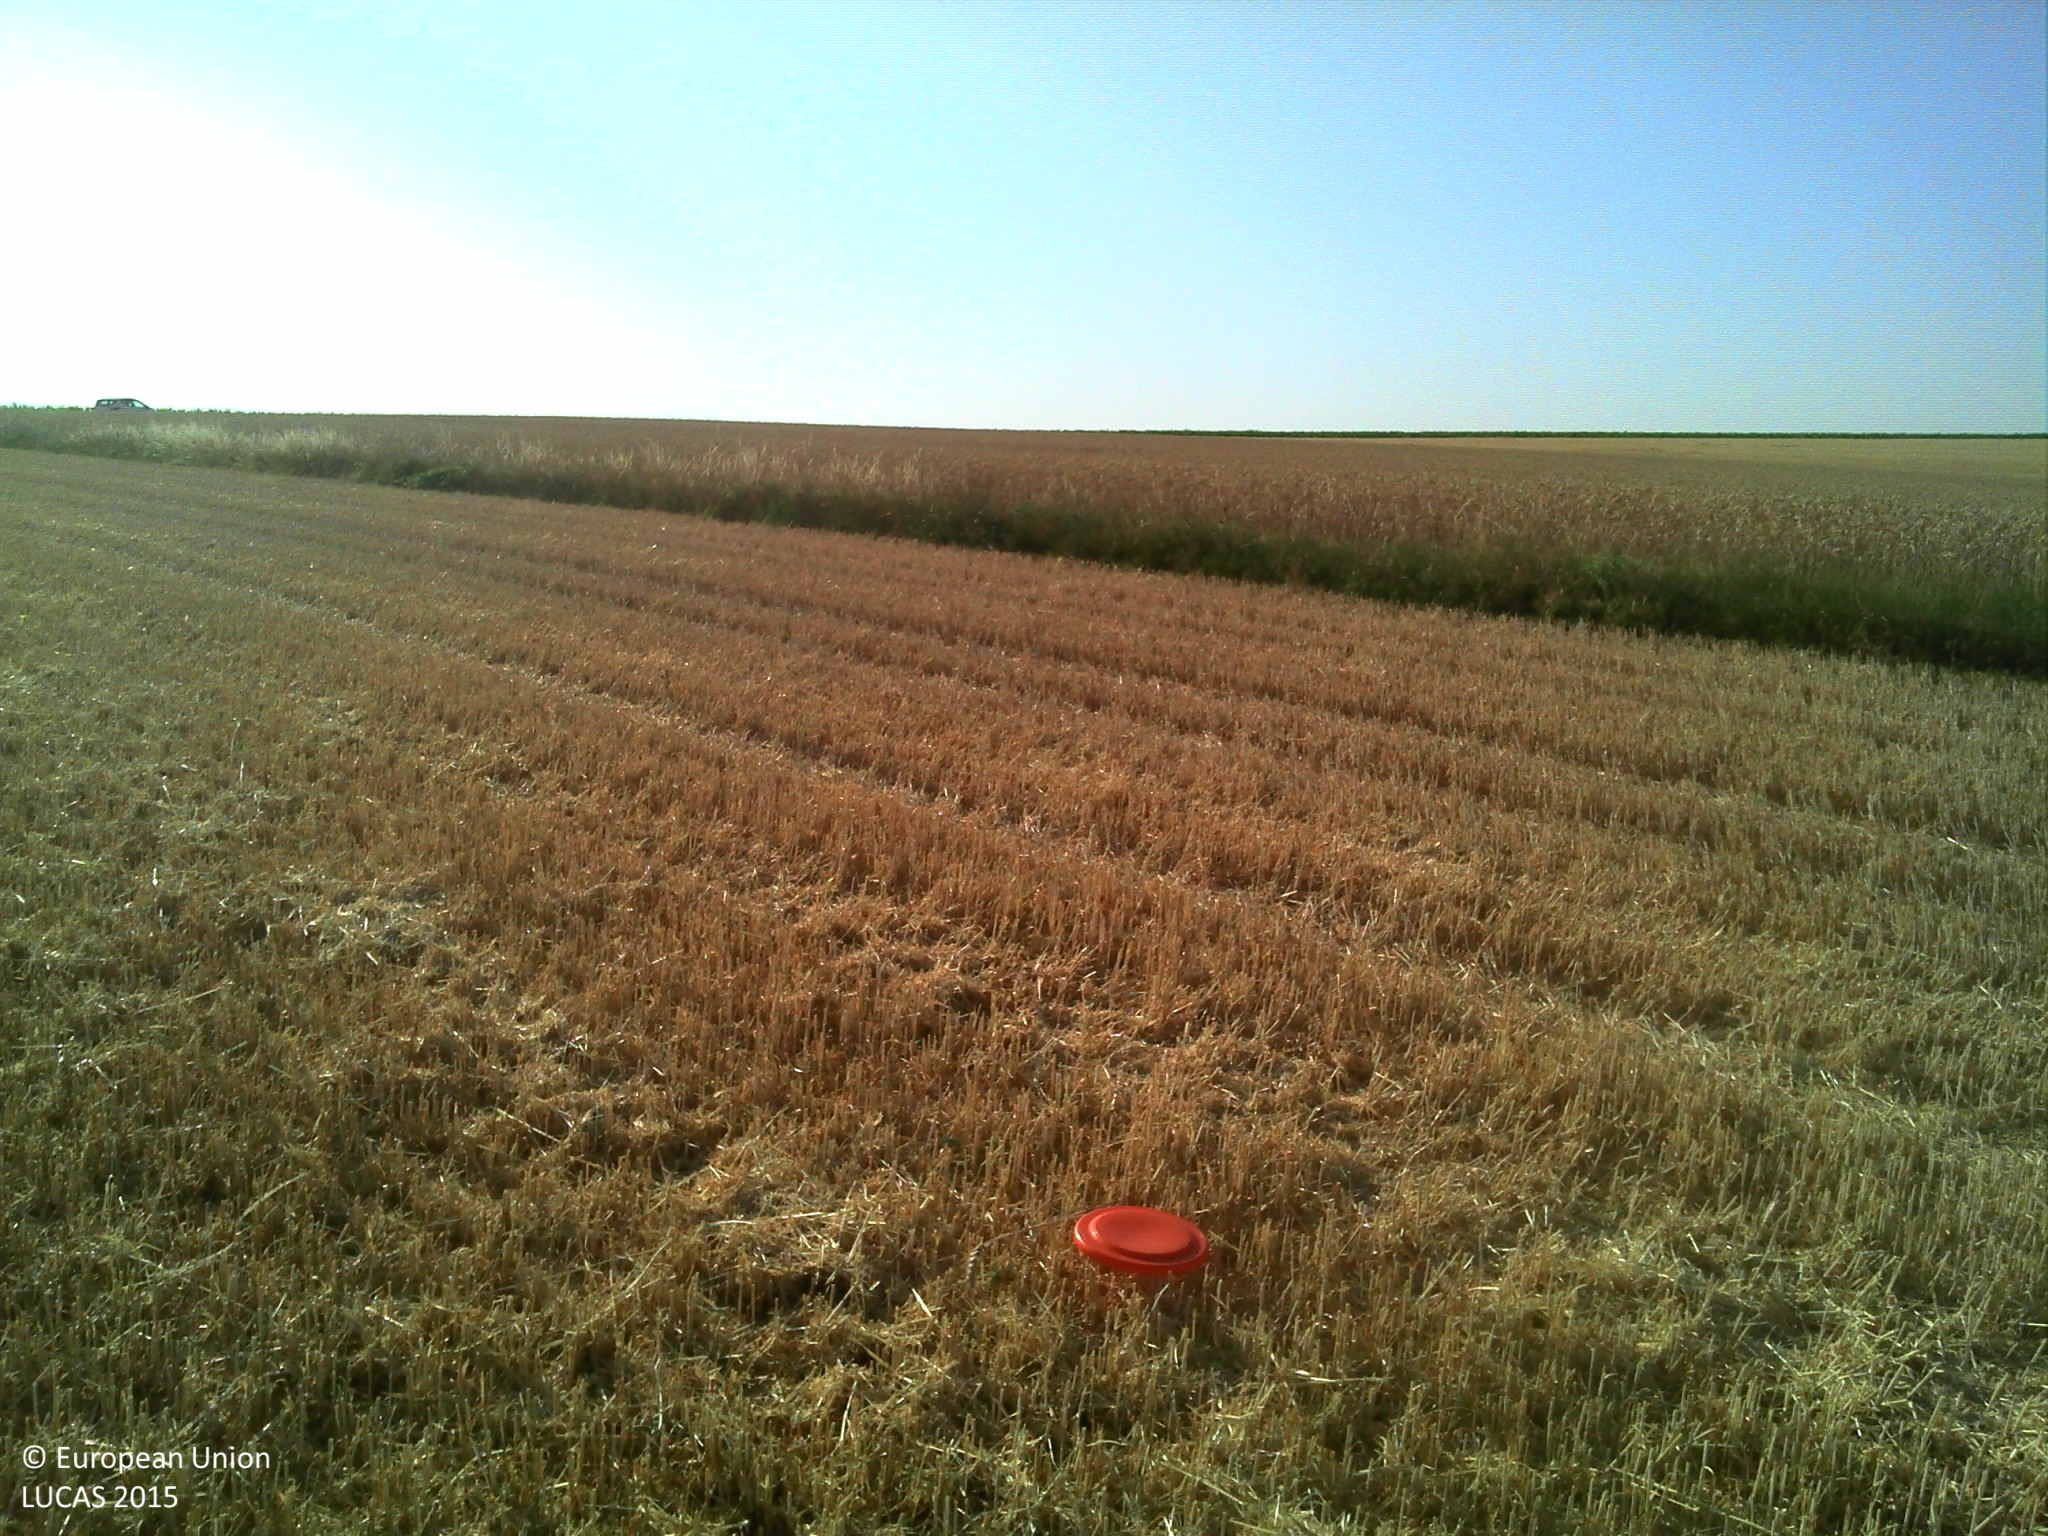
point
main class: Cropland
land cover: Common wheat
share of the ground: > 75 %
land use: Agriculture (excluding fallow land and kitchen gardens)
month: July
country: FR
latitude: 47.6859
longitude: 3.4544
